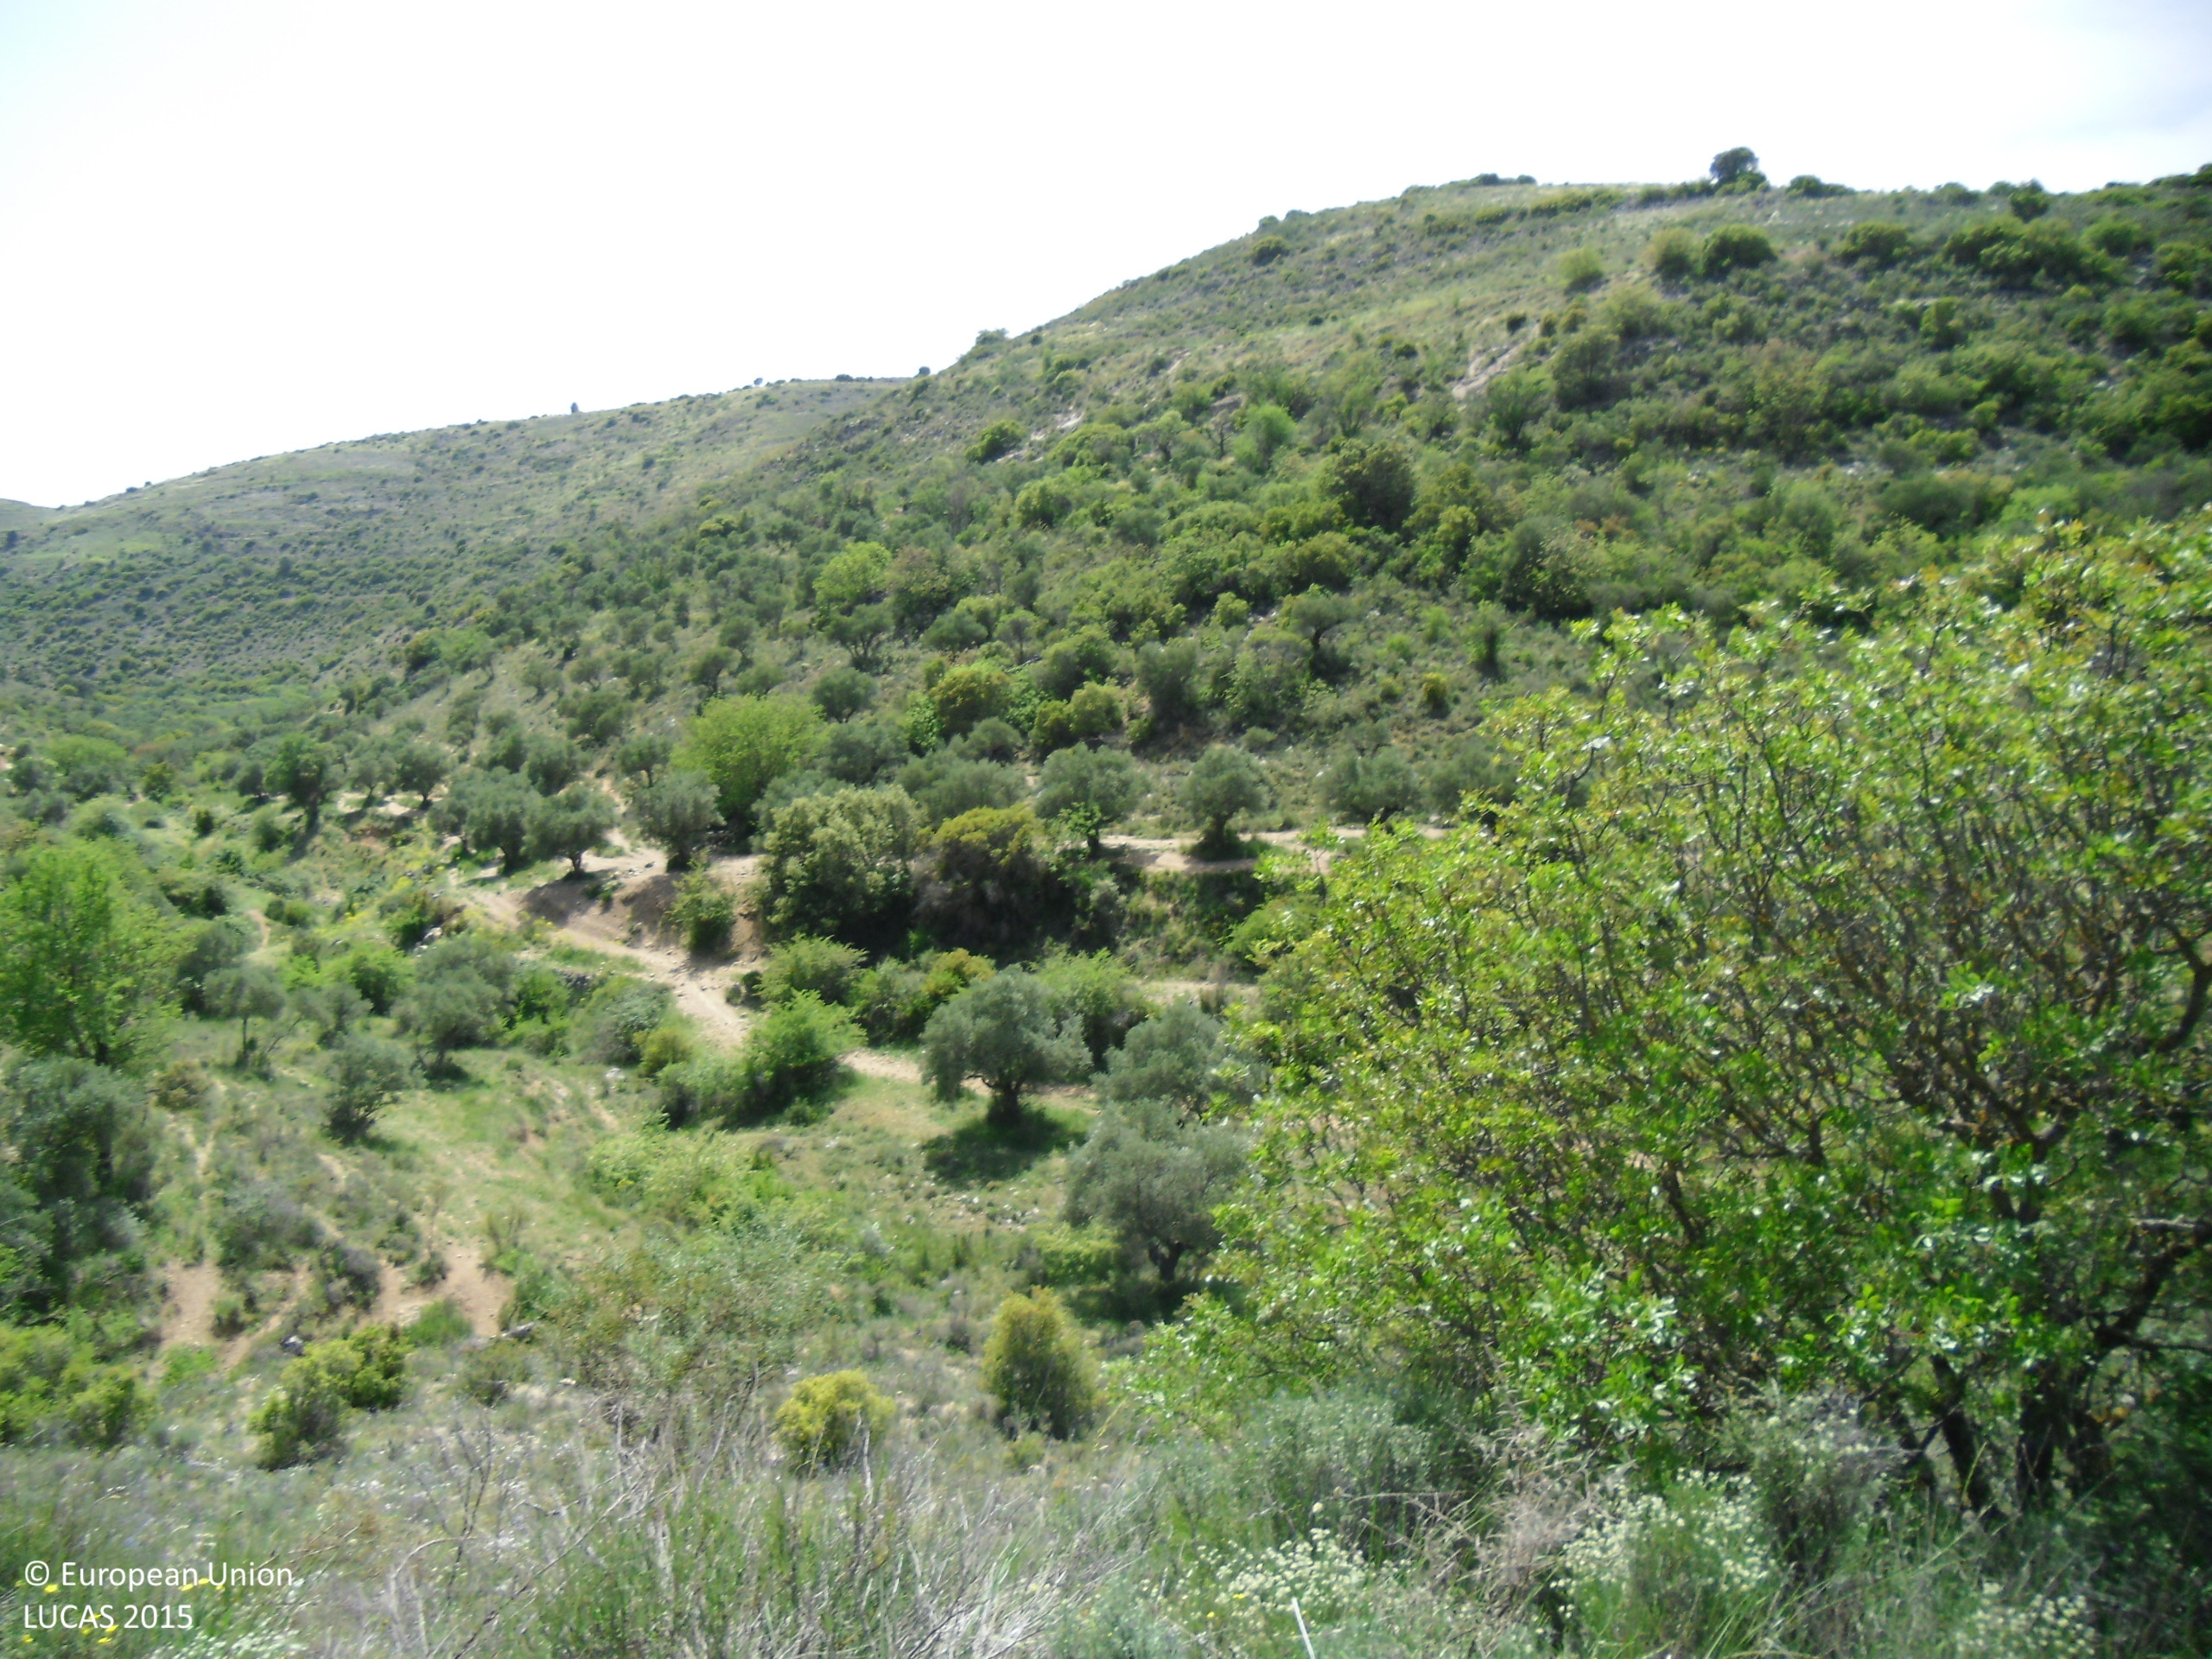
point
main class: Shrubland
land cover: Shrubland with sparse tree cover
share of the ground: 25 - 50 %
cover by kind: herbaceous plants 50 %, shrubs 45 %, broadleaved forest trees 5 %
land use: Semi-natural and natural areas not in use
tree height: < 5 m
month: May
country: ES
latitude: 40.4346
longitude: -2.9127
